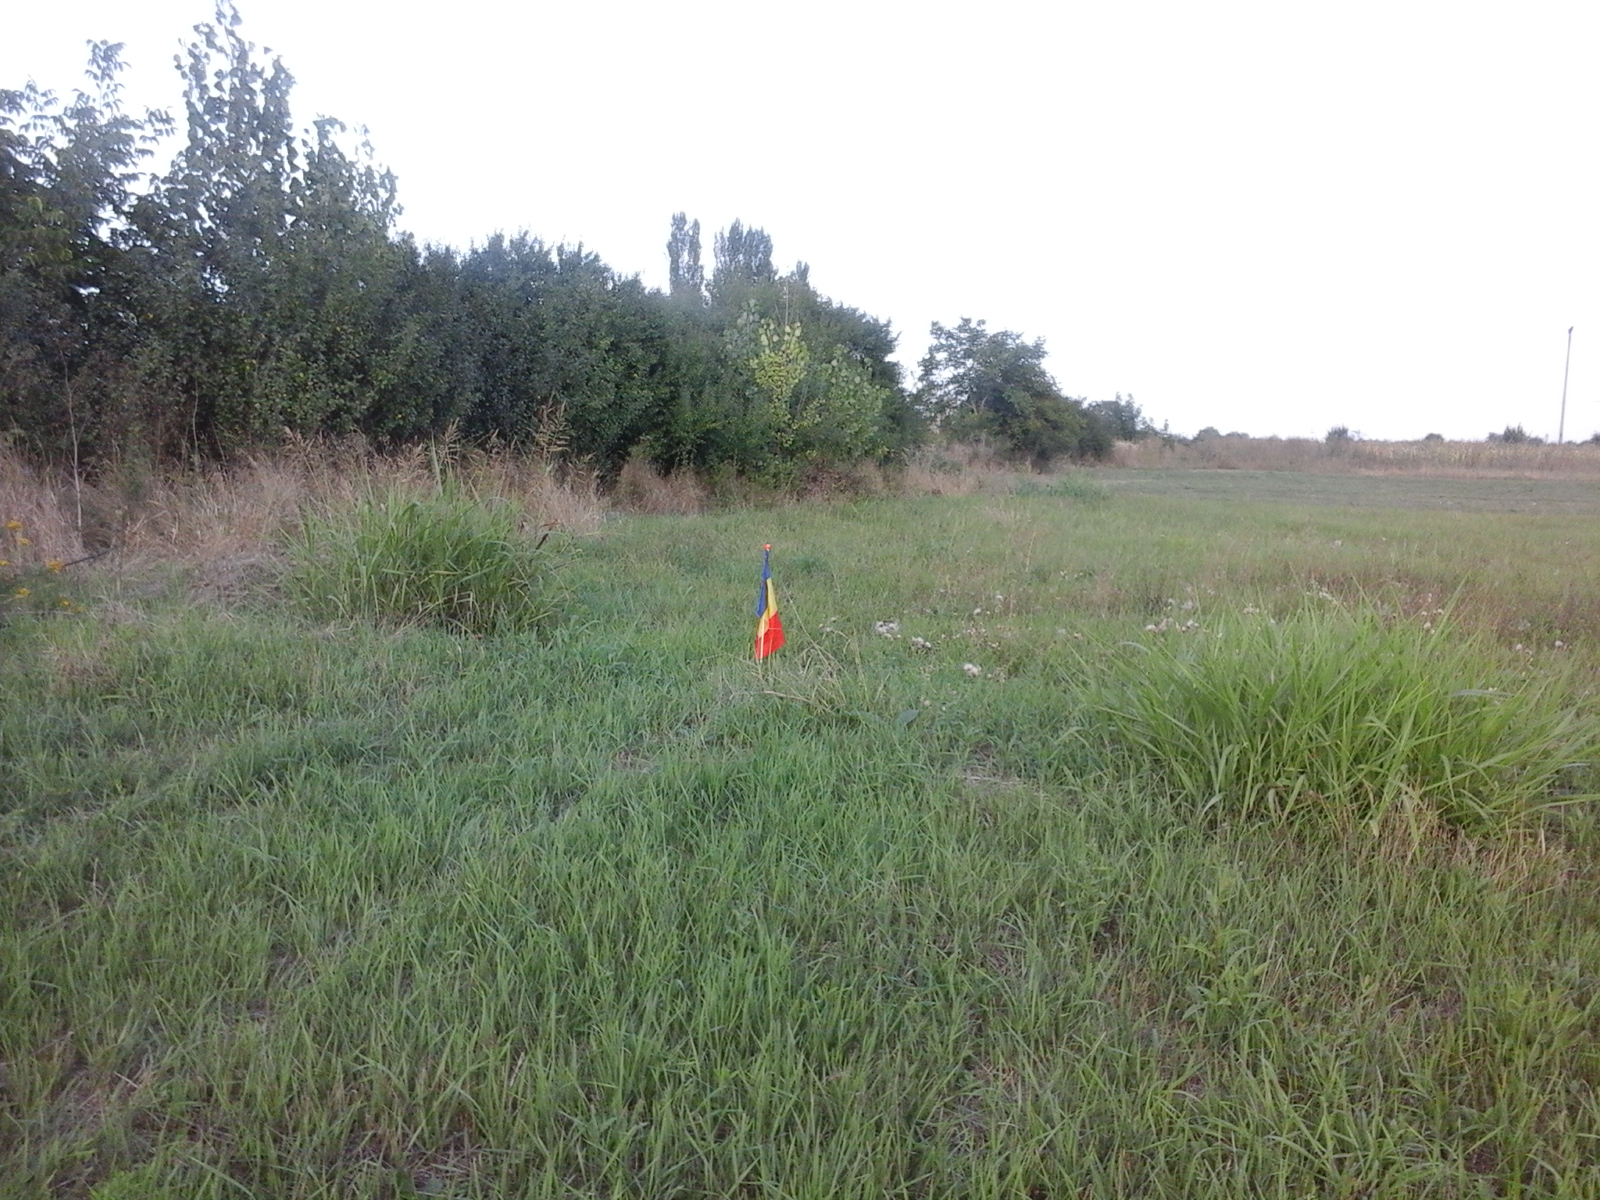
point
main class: Grassland
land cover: Spontaneously vegetated surfaces
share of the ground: > 75 %
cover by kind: herbaceous plants 100 %
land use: Agriculture (excluding fallow land and kitchen gardens)
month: August
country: RO
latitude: 46.4449
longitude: 21.7693
